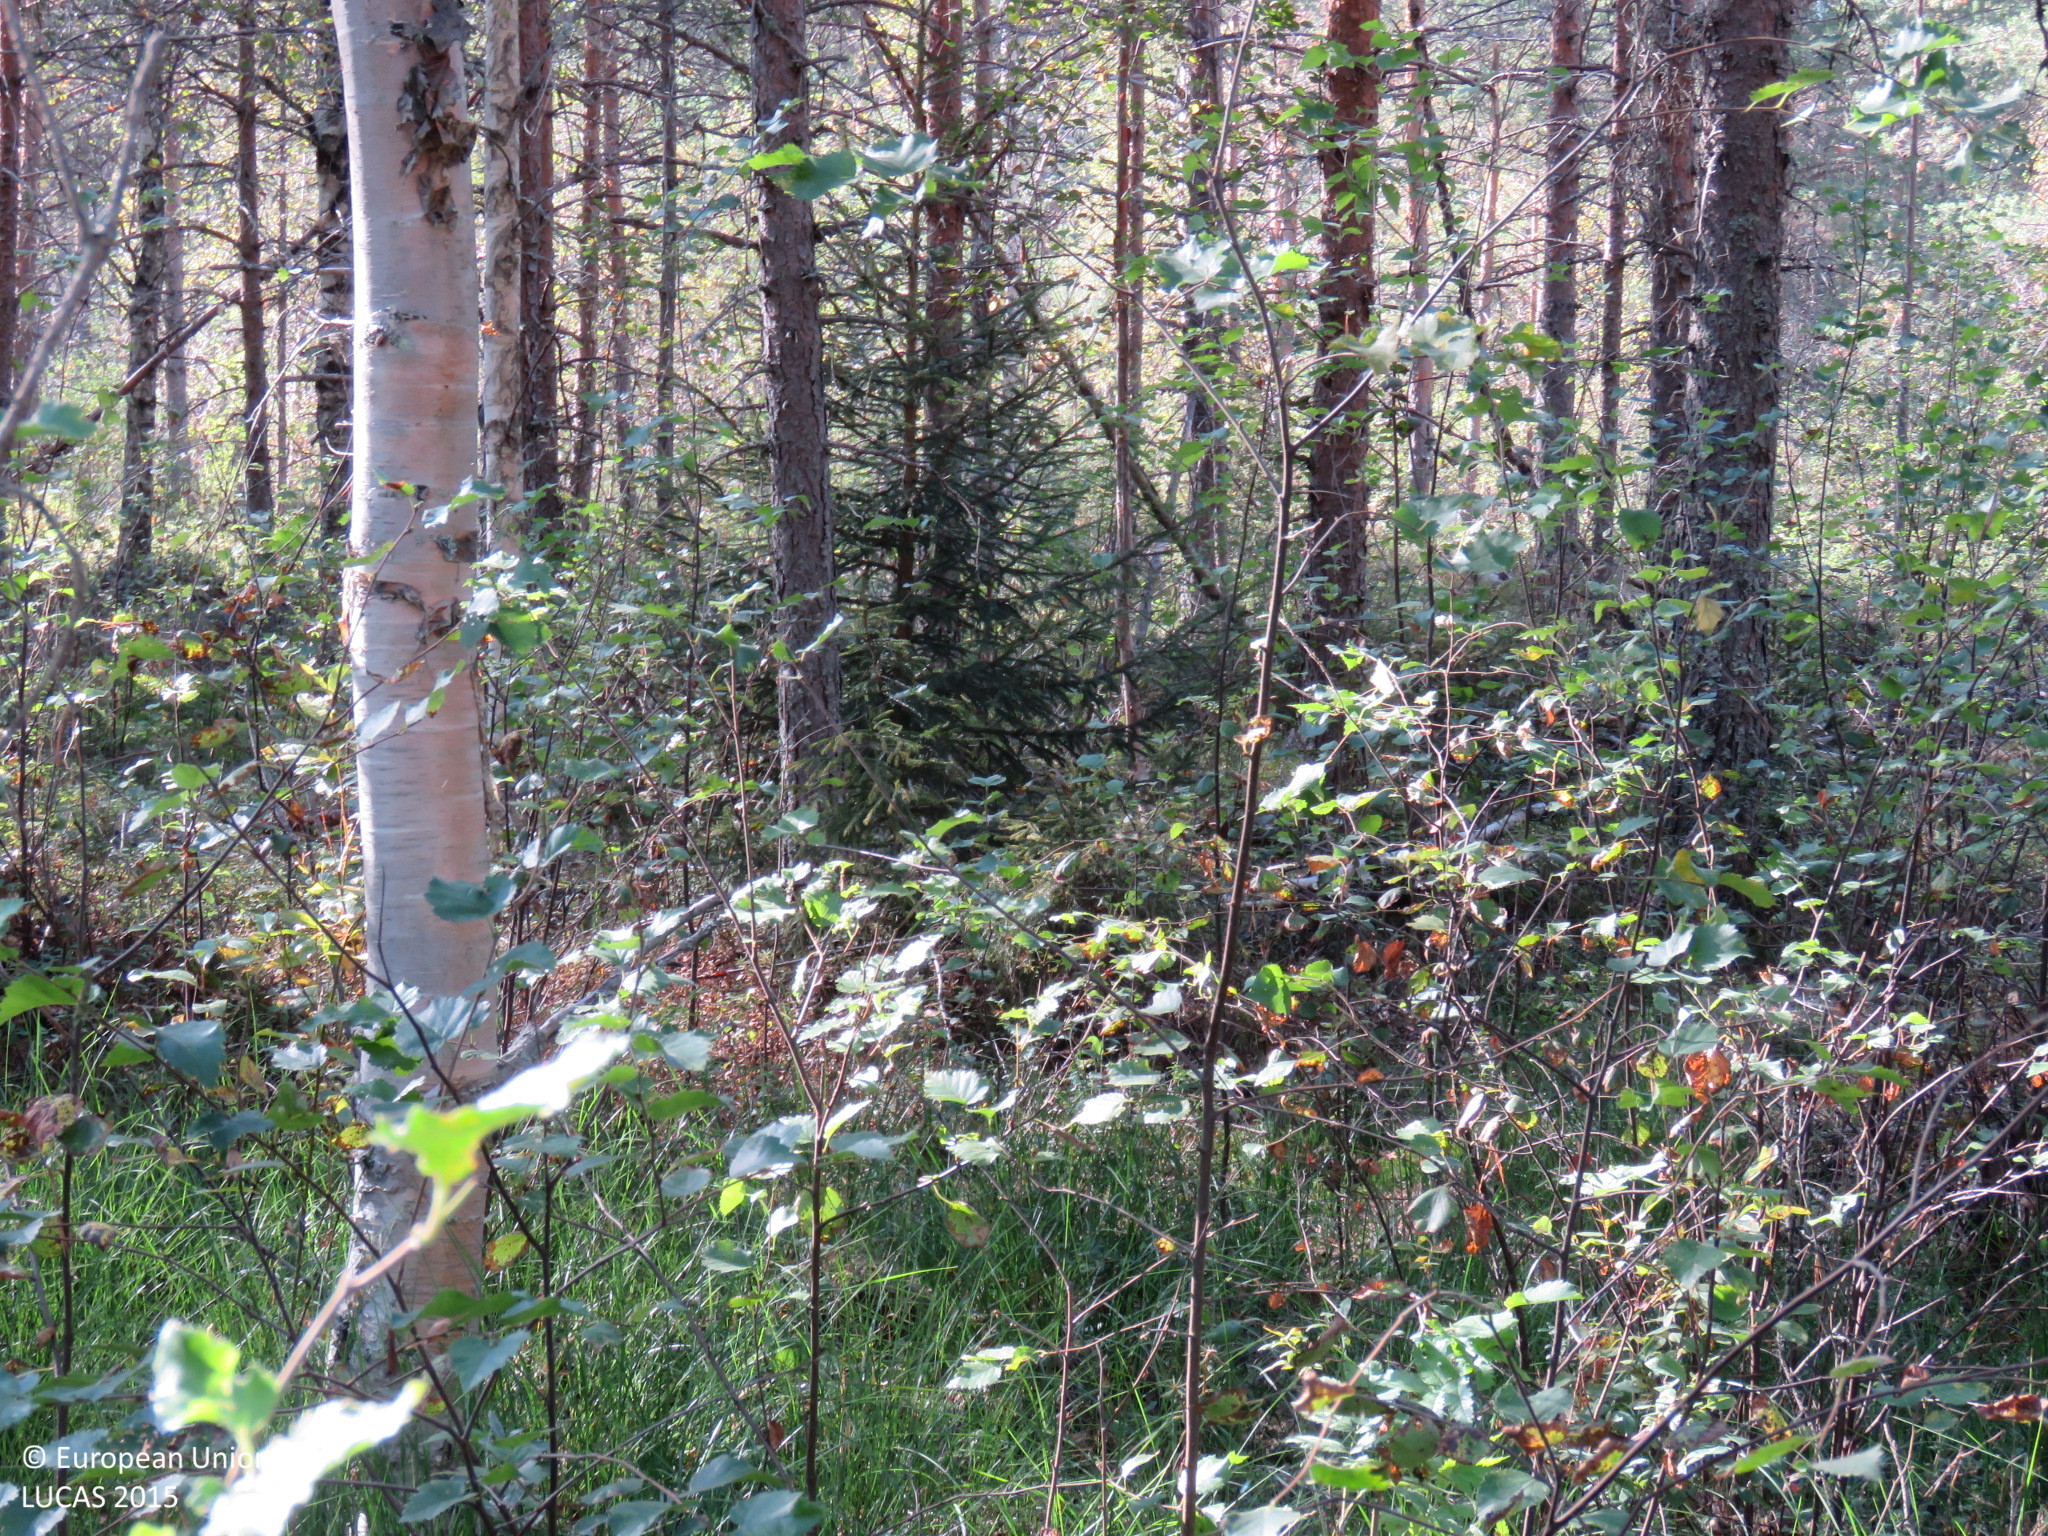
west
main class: Woodland
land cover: Pine dominated mixed woodland
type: mire and swamp forests
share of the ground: > 75 %
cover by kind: coniferous forest trees 60 %, broadleaved forest trees 25 %, shrubs 10 %, herbaceous plants 5 %
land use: Forestry
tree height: > 5 m
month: August
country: FI
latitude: 64.9998
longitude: 25.6745
